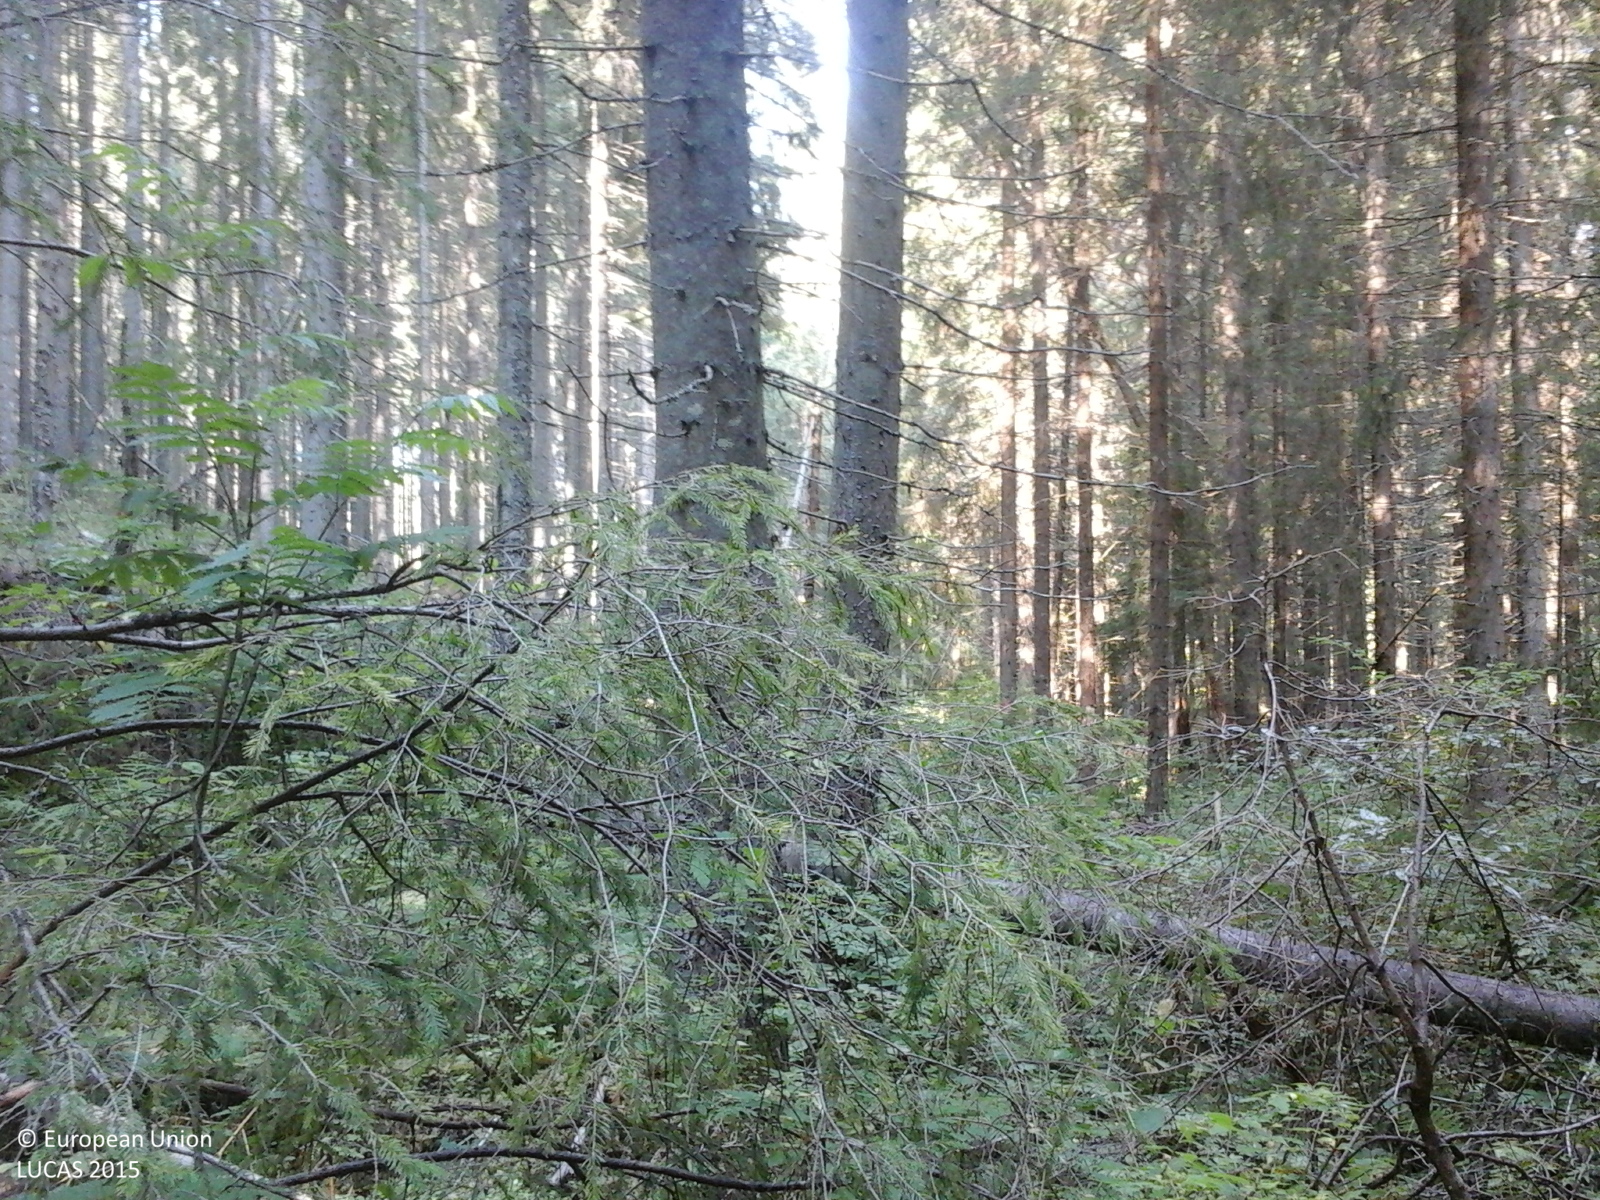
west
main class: Woodland
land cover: Spruce dominated coniferous woodland
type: alpine coniferous forest
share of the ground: > 75 %
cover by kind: coniferous forest trees 100 %
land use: Forestry
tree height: > 5 m
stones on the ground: < 10 %
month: September
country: RO
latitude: 47.2487
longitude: 25.1011
